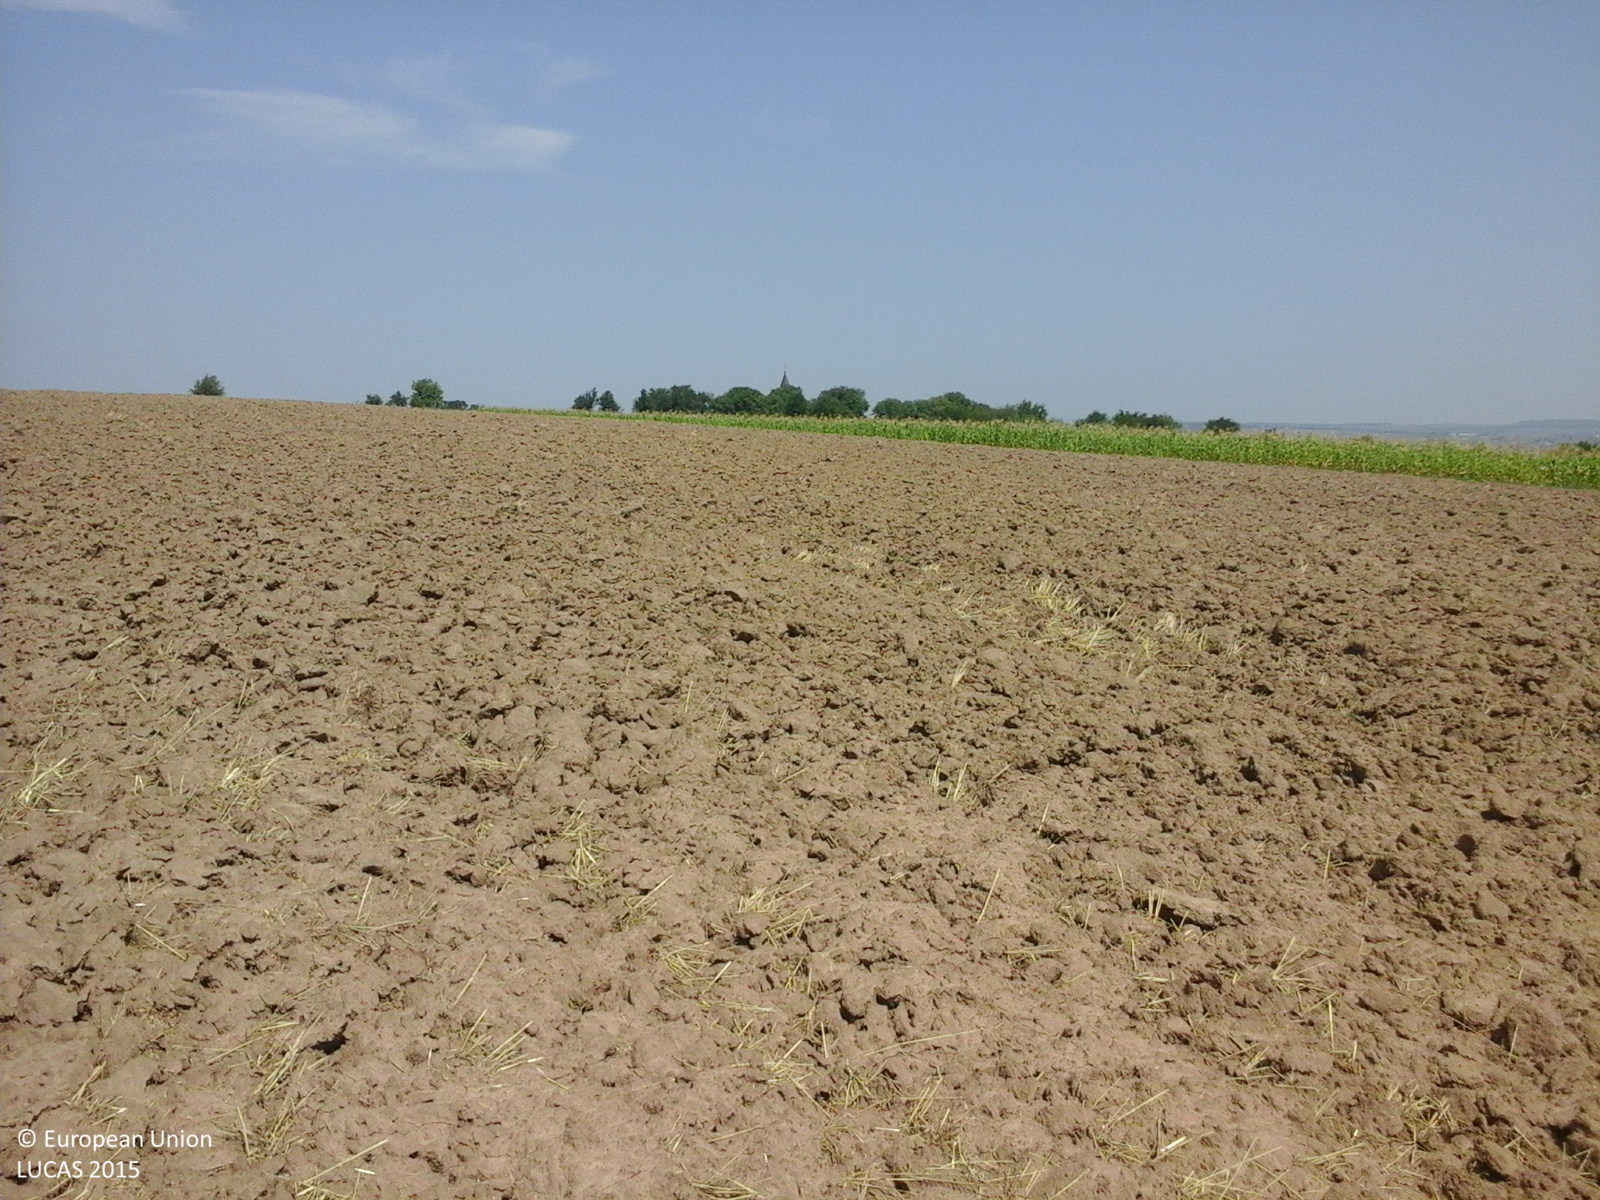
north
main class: Cropland
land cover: Common wheat
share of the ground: < 10 %
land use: Agriculture (excluding fallow land and kitchen gardens)
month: August
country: RO
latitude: 46.2351
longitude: 27.0703
